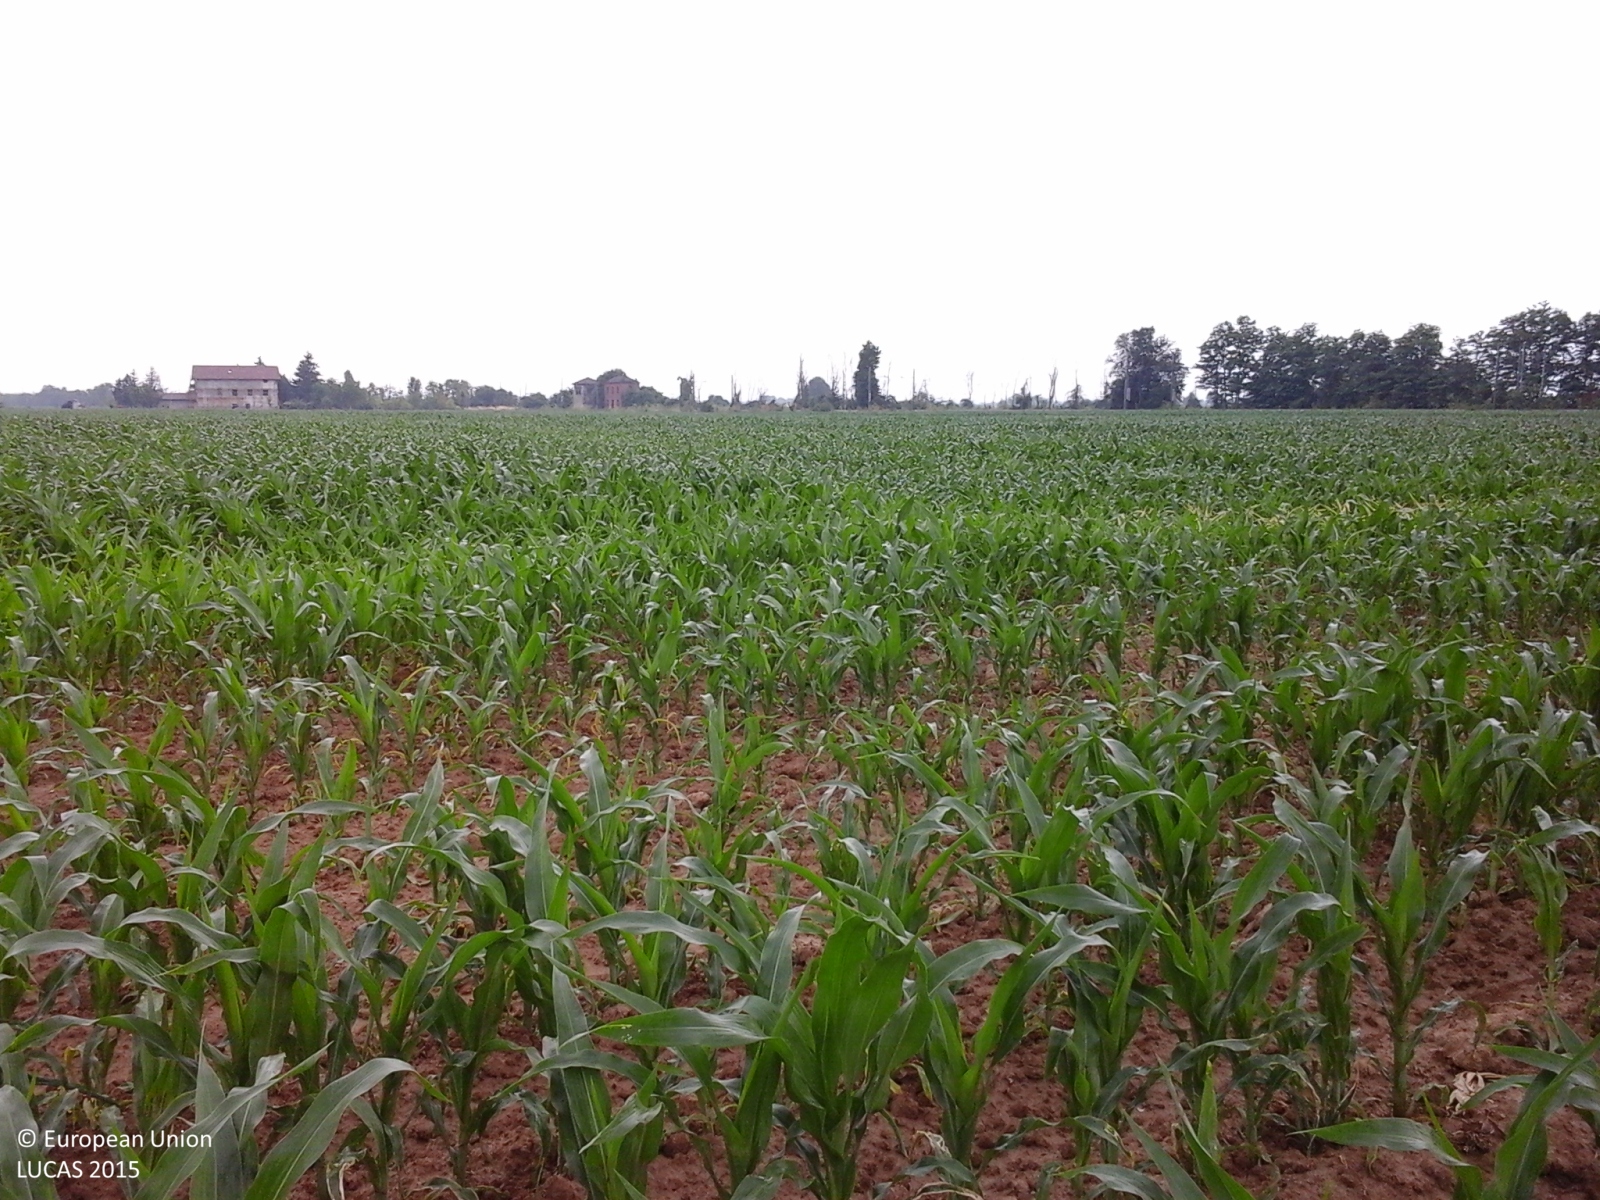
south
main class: Cropland
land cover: Maize
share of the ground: < 10 %
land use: Agriculture (excluding fallow land and kitchen gardens)
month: June
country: IT
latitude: 44.8117
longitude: 8.7255
